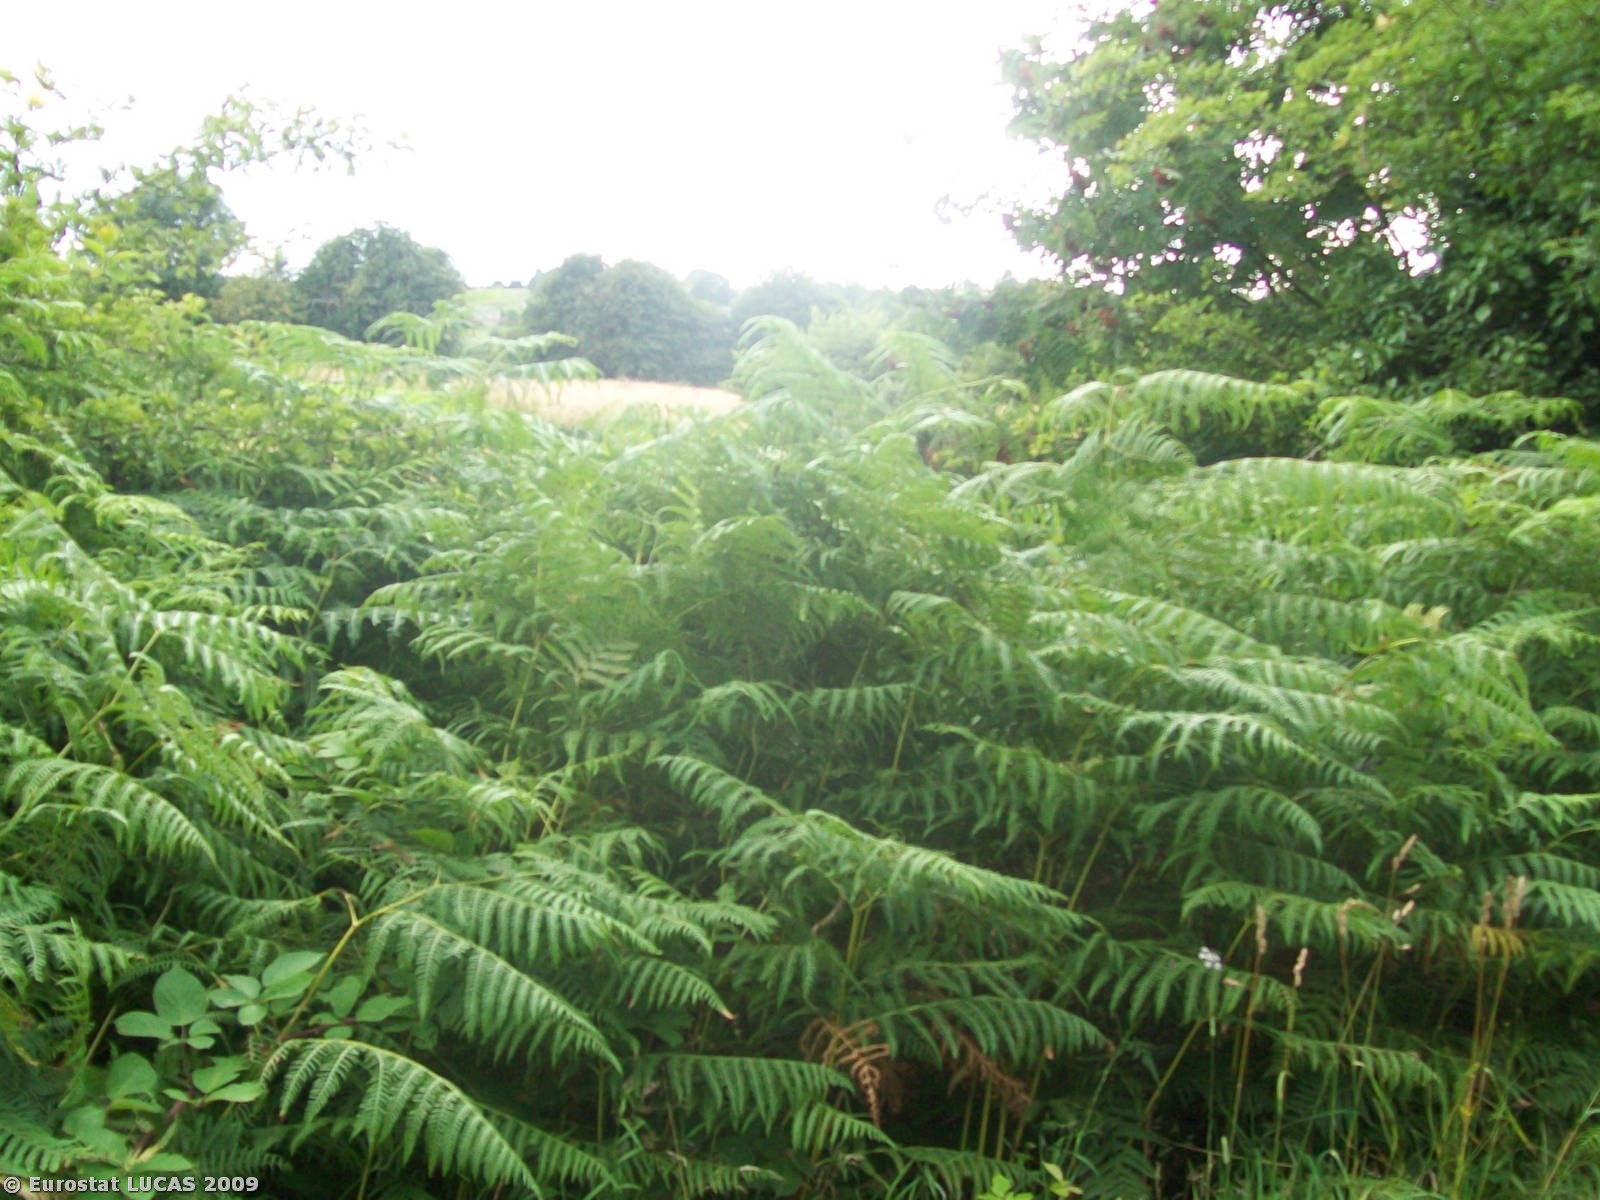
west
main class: Woodland
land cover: Coniferous woodland
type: plantations and self-sown exotic forest
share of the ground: > 75 %
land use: Forestry
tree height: > 5 m
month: July
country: IE
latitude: 54.0489
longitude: -9.0774
